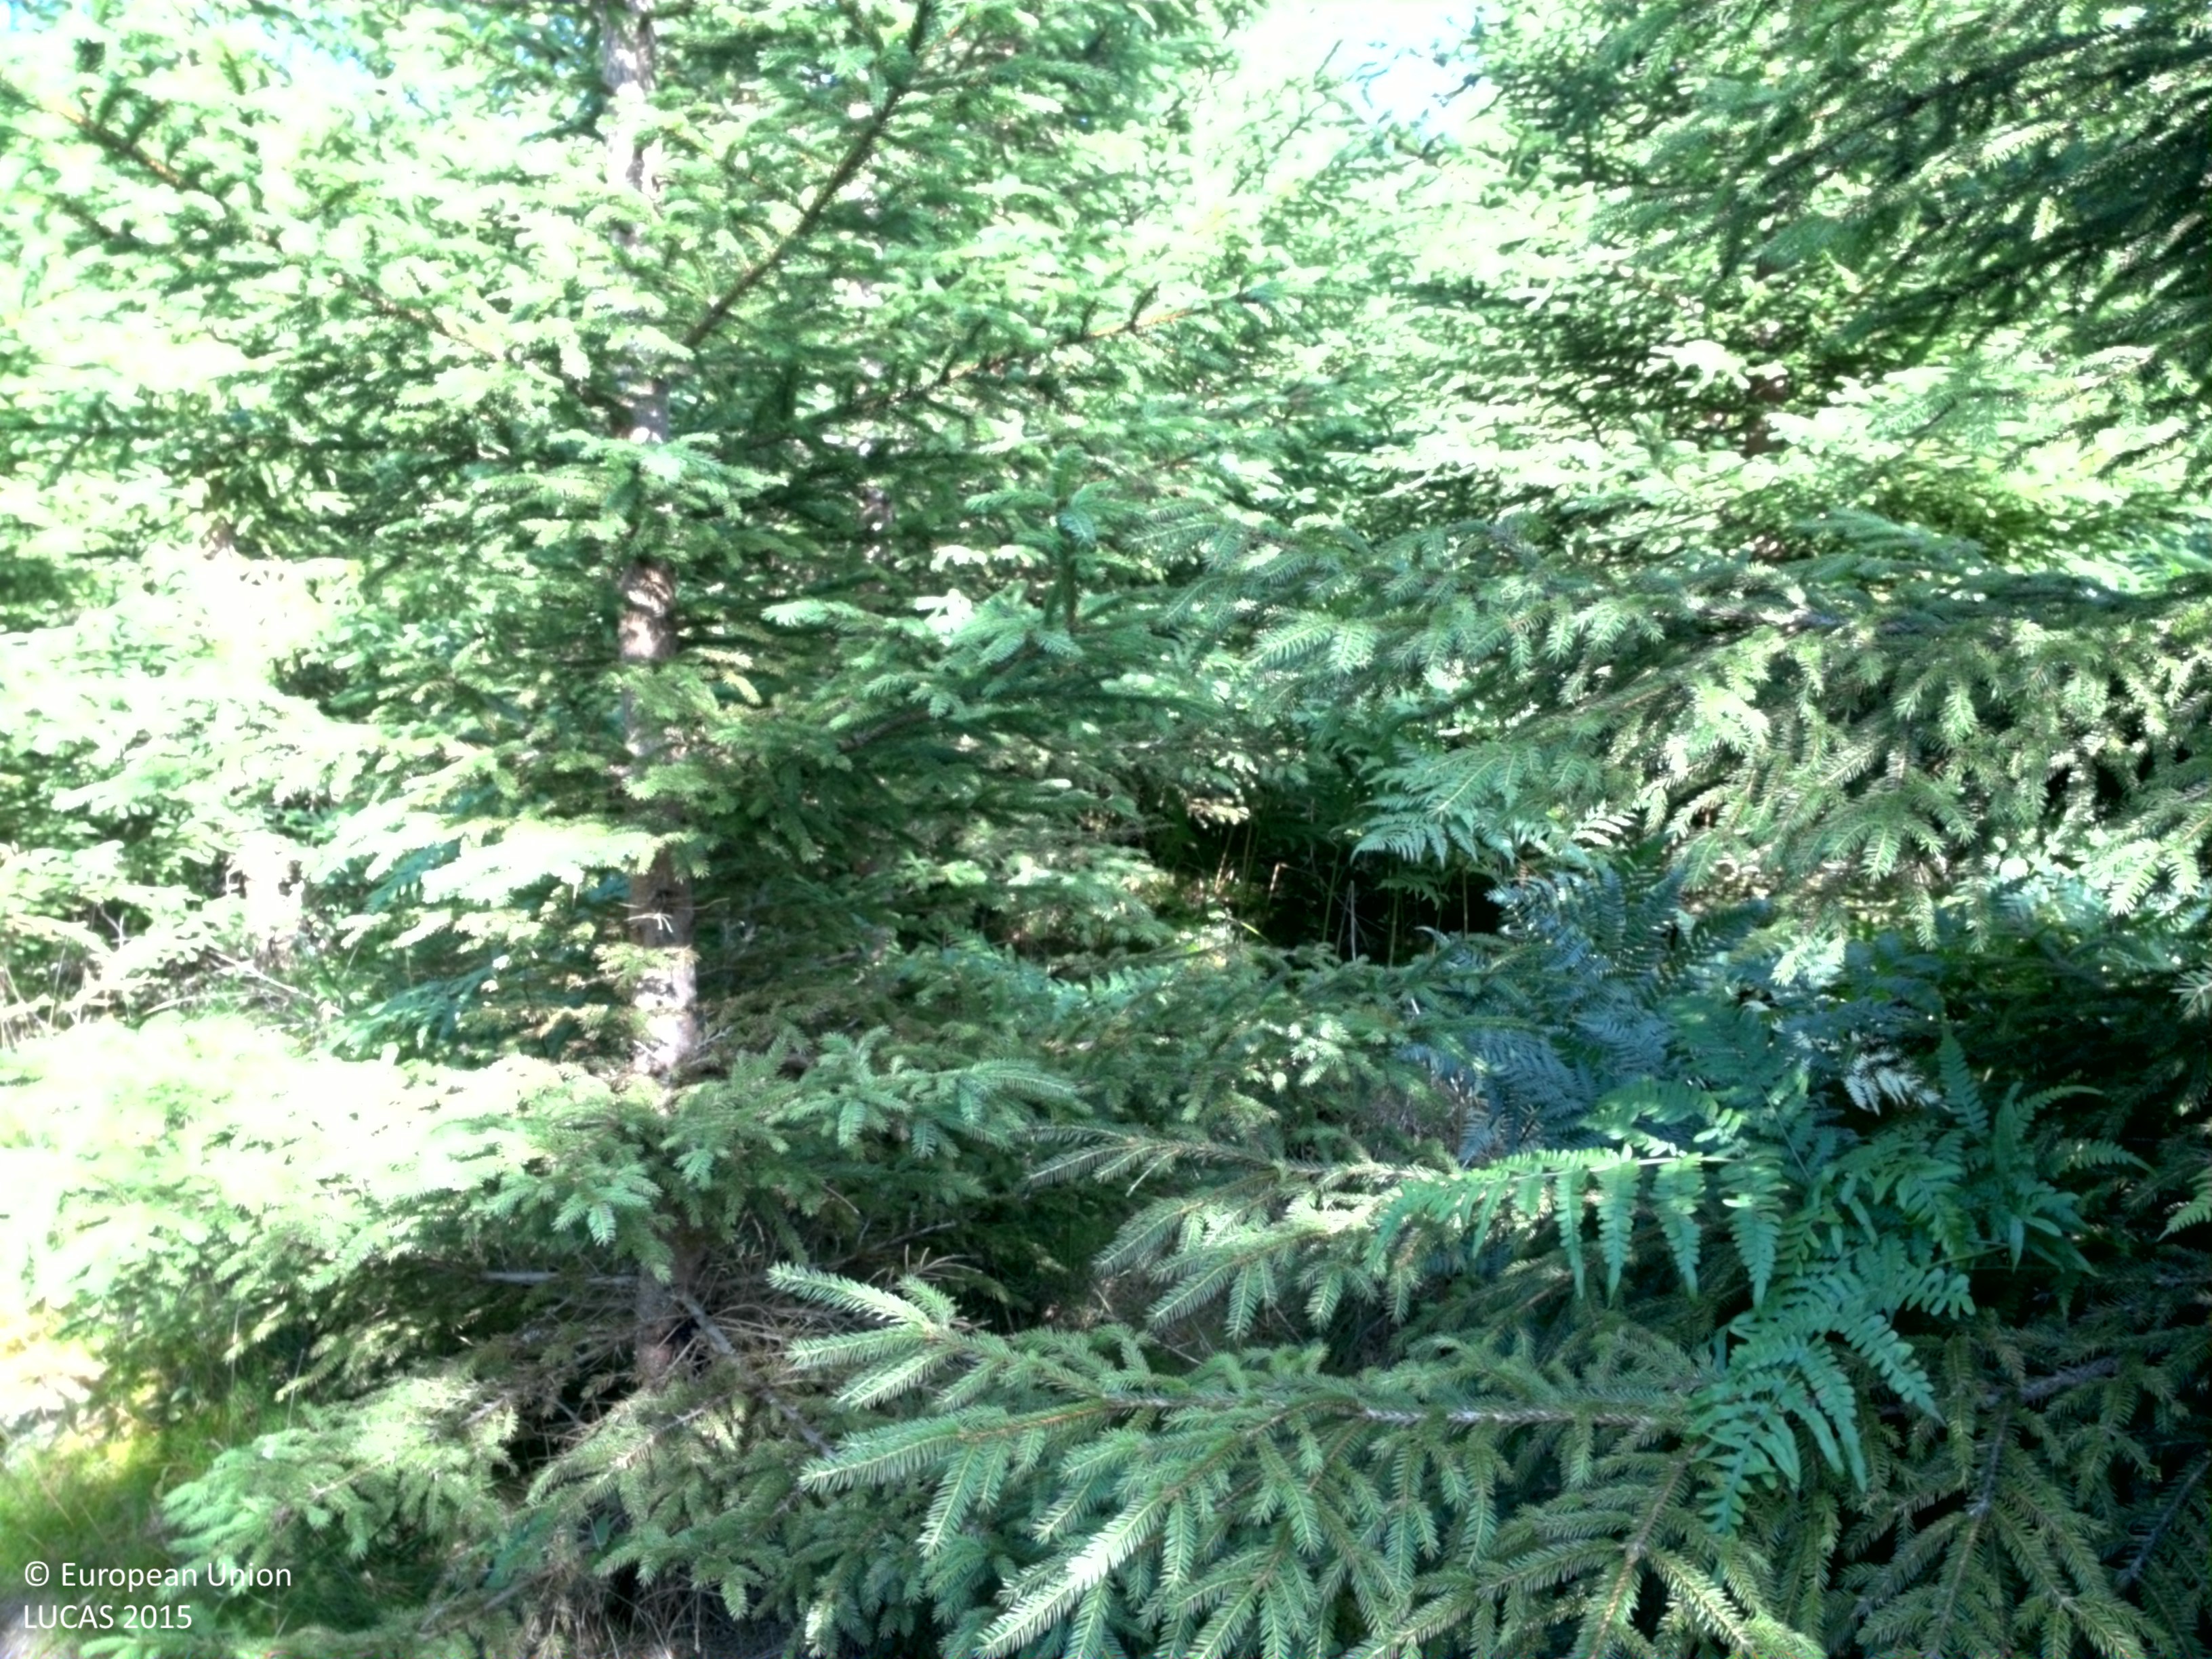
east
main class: Woodland
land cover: Spruce dominated coniferous woodland
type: boreal forest
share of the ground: 50 - 75 %
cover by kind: coniferous forest trees 50 %, lichens and mosses 30 %, herbaceous plants 20 %
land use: Forestry
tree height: < 5 m
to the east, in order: Spruce dominated coniferous woodland; Paved roads, cycling and walking lanes; Pine dominated coniferous woodland; Ditches and canals; Tracks
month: August
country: SE
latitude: 58.1065
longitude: 13.9822
